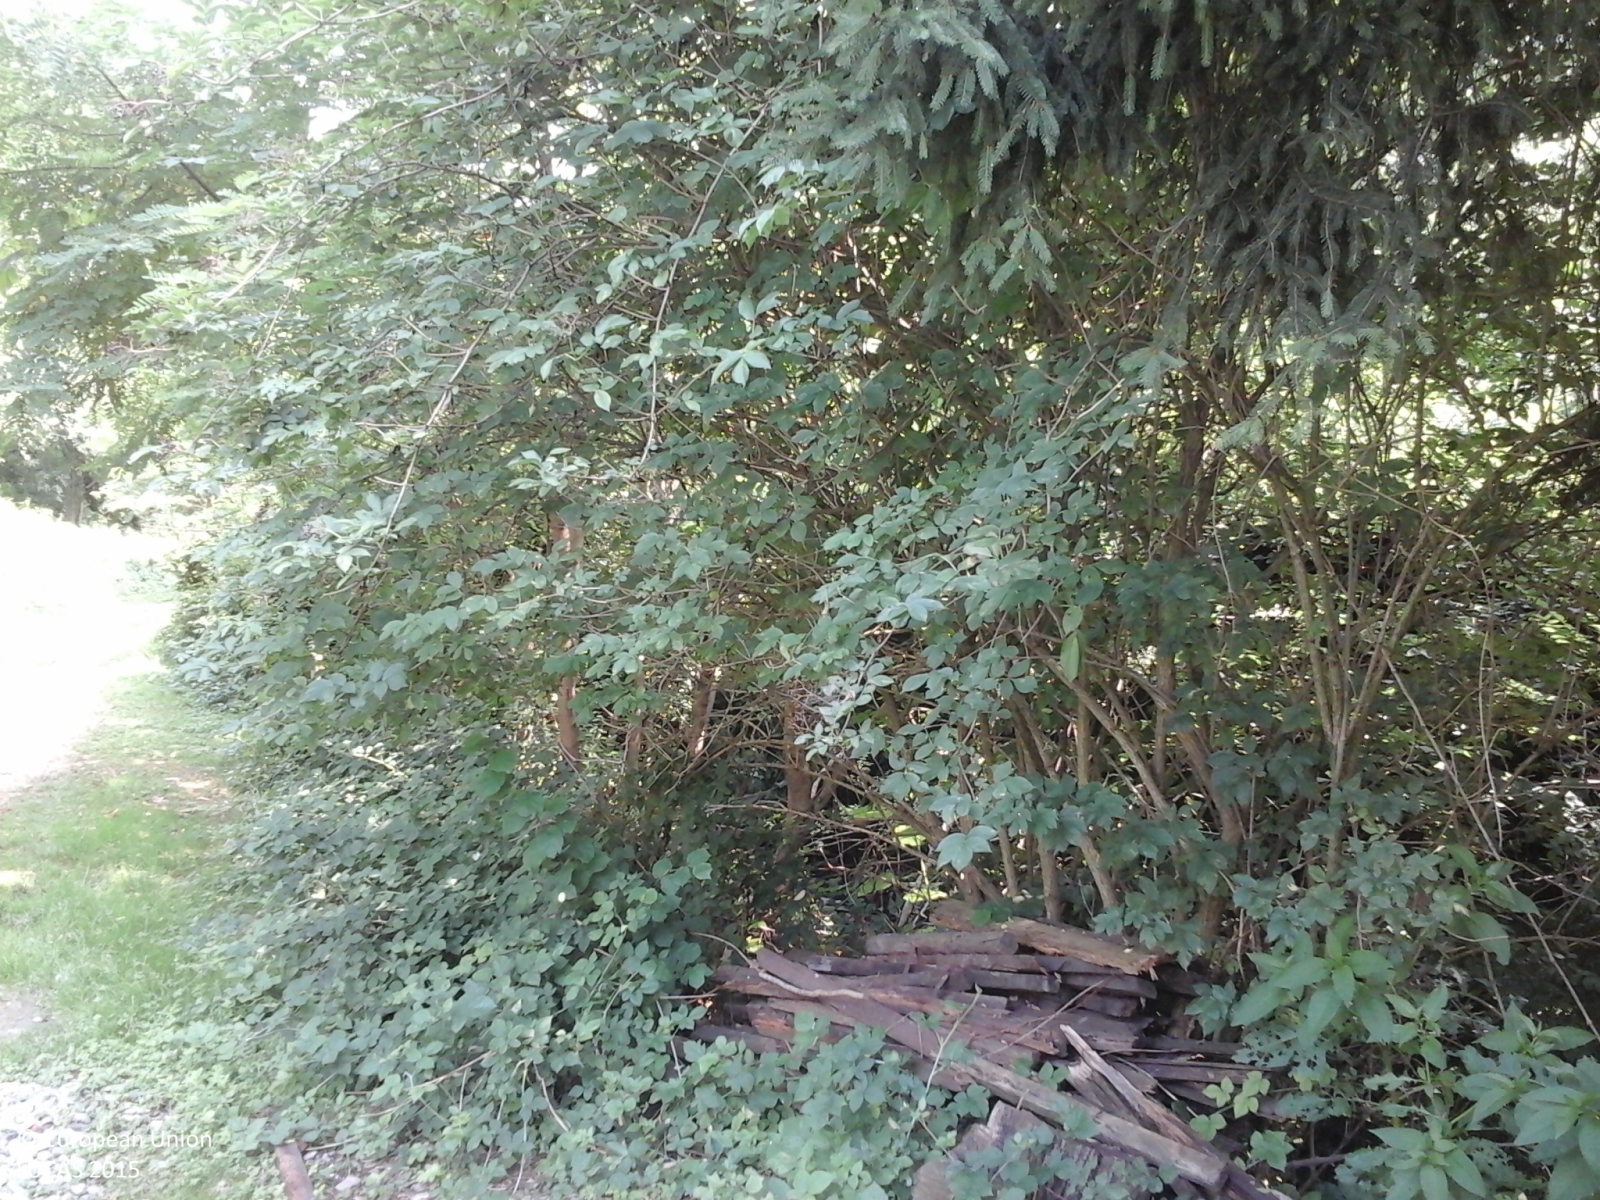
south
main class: Woodland
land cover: Broadleaved woodland
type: thermophilous deciduous forest
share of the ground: > 75 %
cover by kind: broadleaved forest trees 100 %
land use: Semi-natural and natural areas not in use
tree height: > 5 m
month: July
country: IT
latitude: 45.0653
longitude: 7.7307
